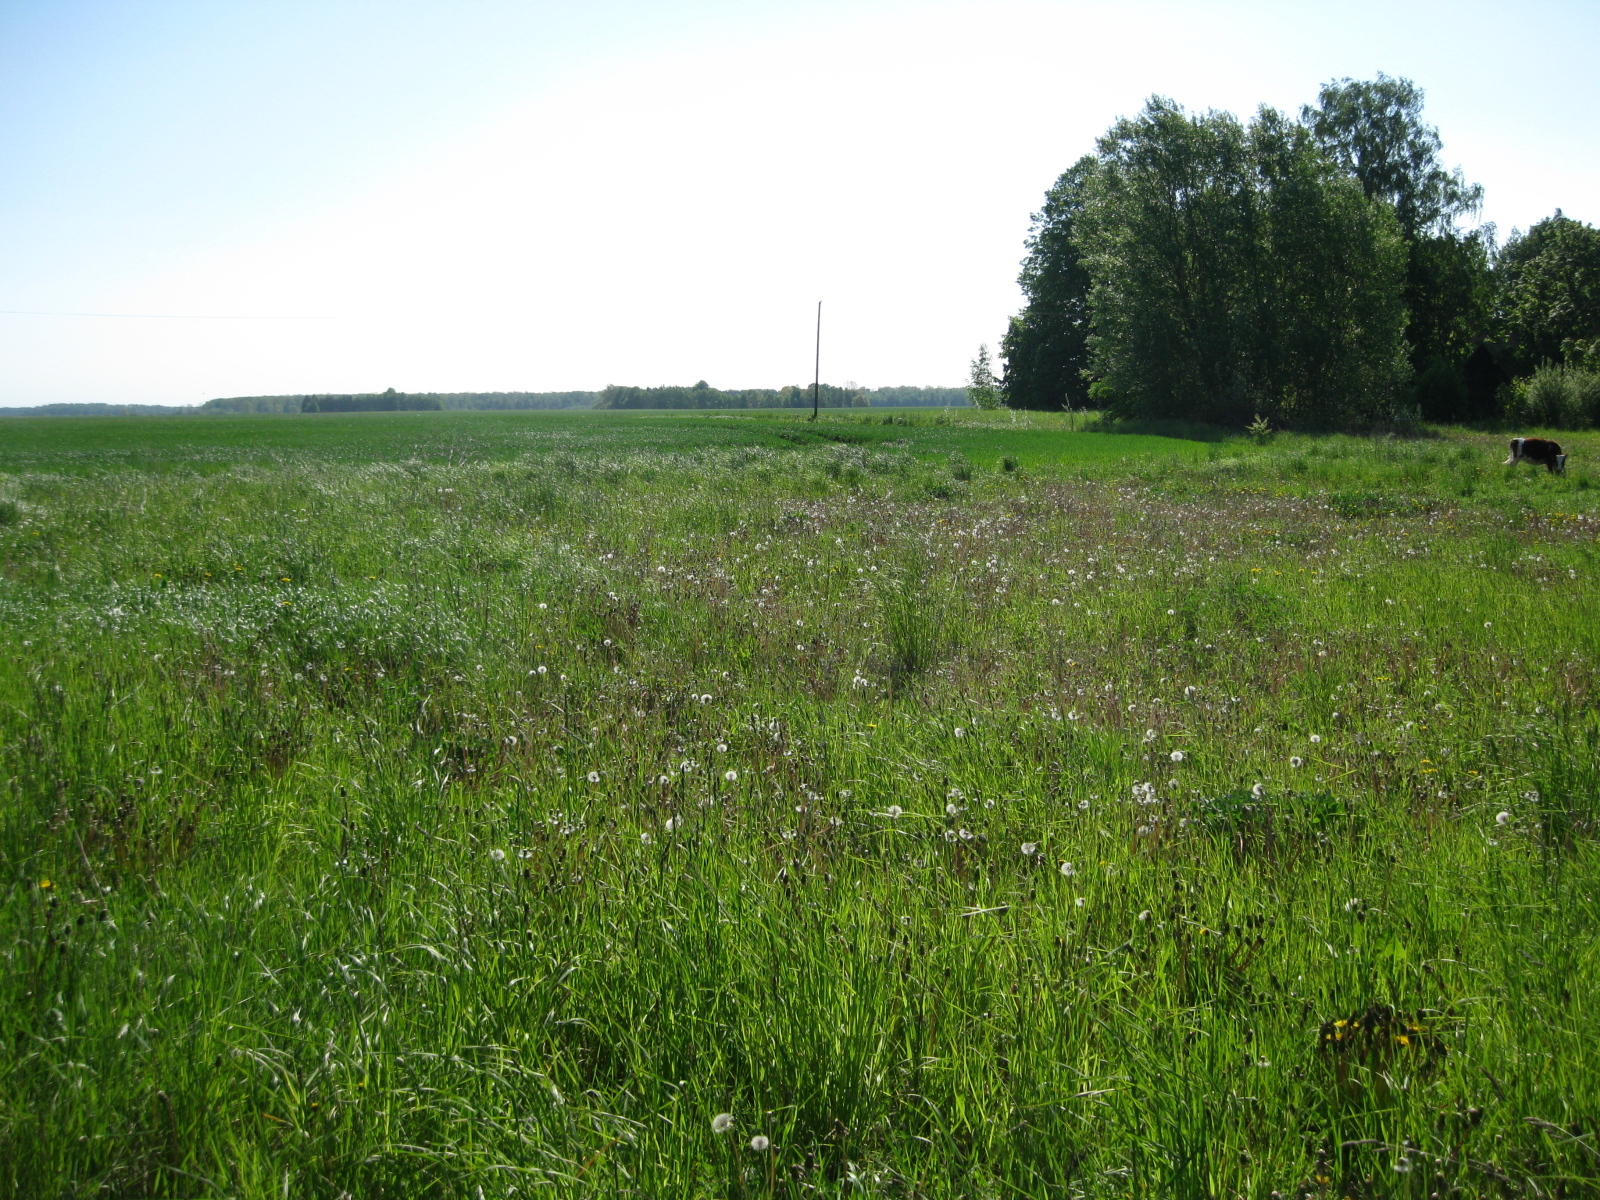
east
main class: Grassland
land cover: Grassland without tree/shrub cover
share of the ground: > 75 %
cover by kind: herbaceous plants 100 %
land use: Agriculture (excluding fallow land and kitchen gardens)
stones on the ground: < 10 %
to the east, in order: Grassland without tree/shrub cover; Common wheat; Electric lines; Common wheat; Grass margins; Paved roads, cycling and walking lanes; Grass margins; Common wheat
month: May
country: LT
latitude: 56.0961
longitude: 24.1227
